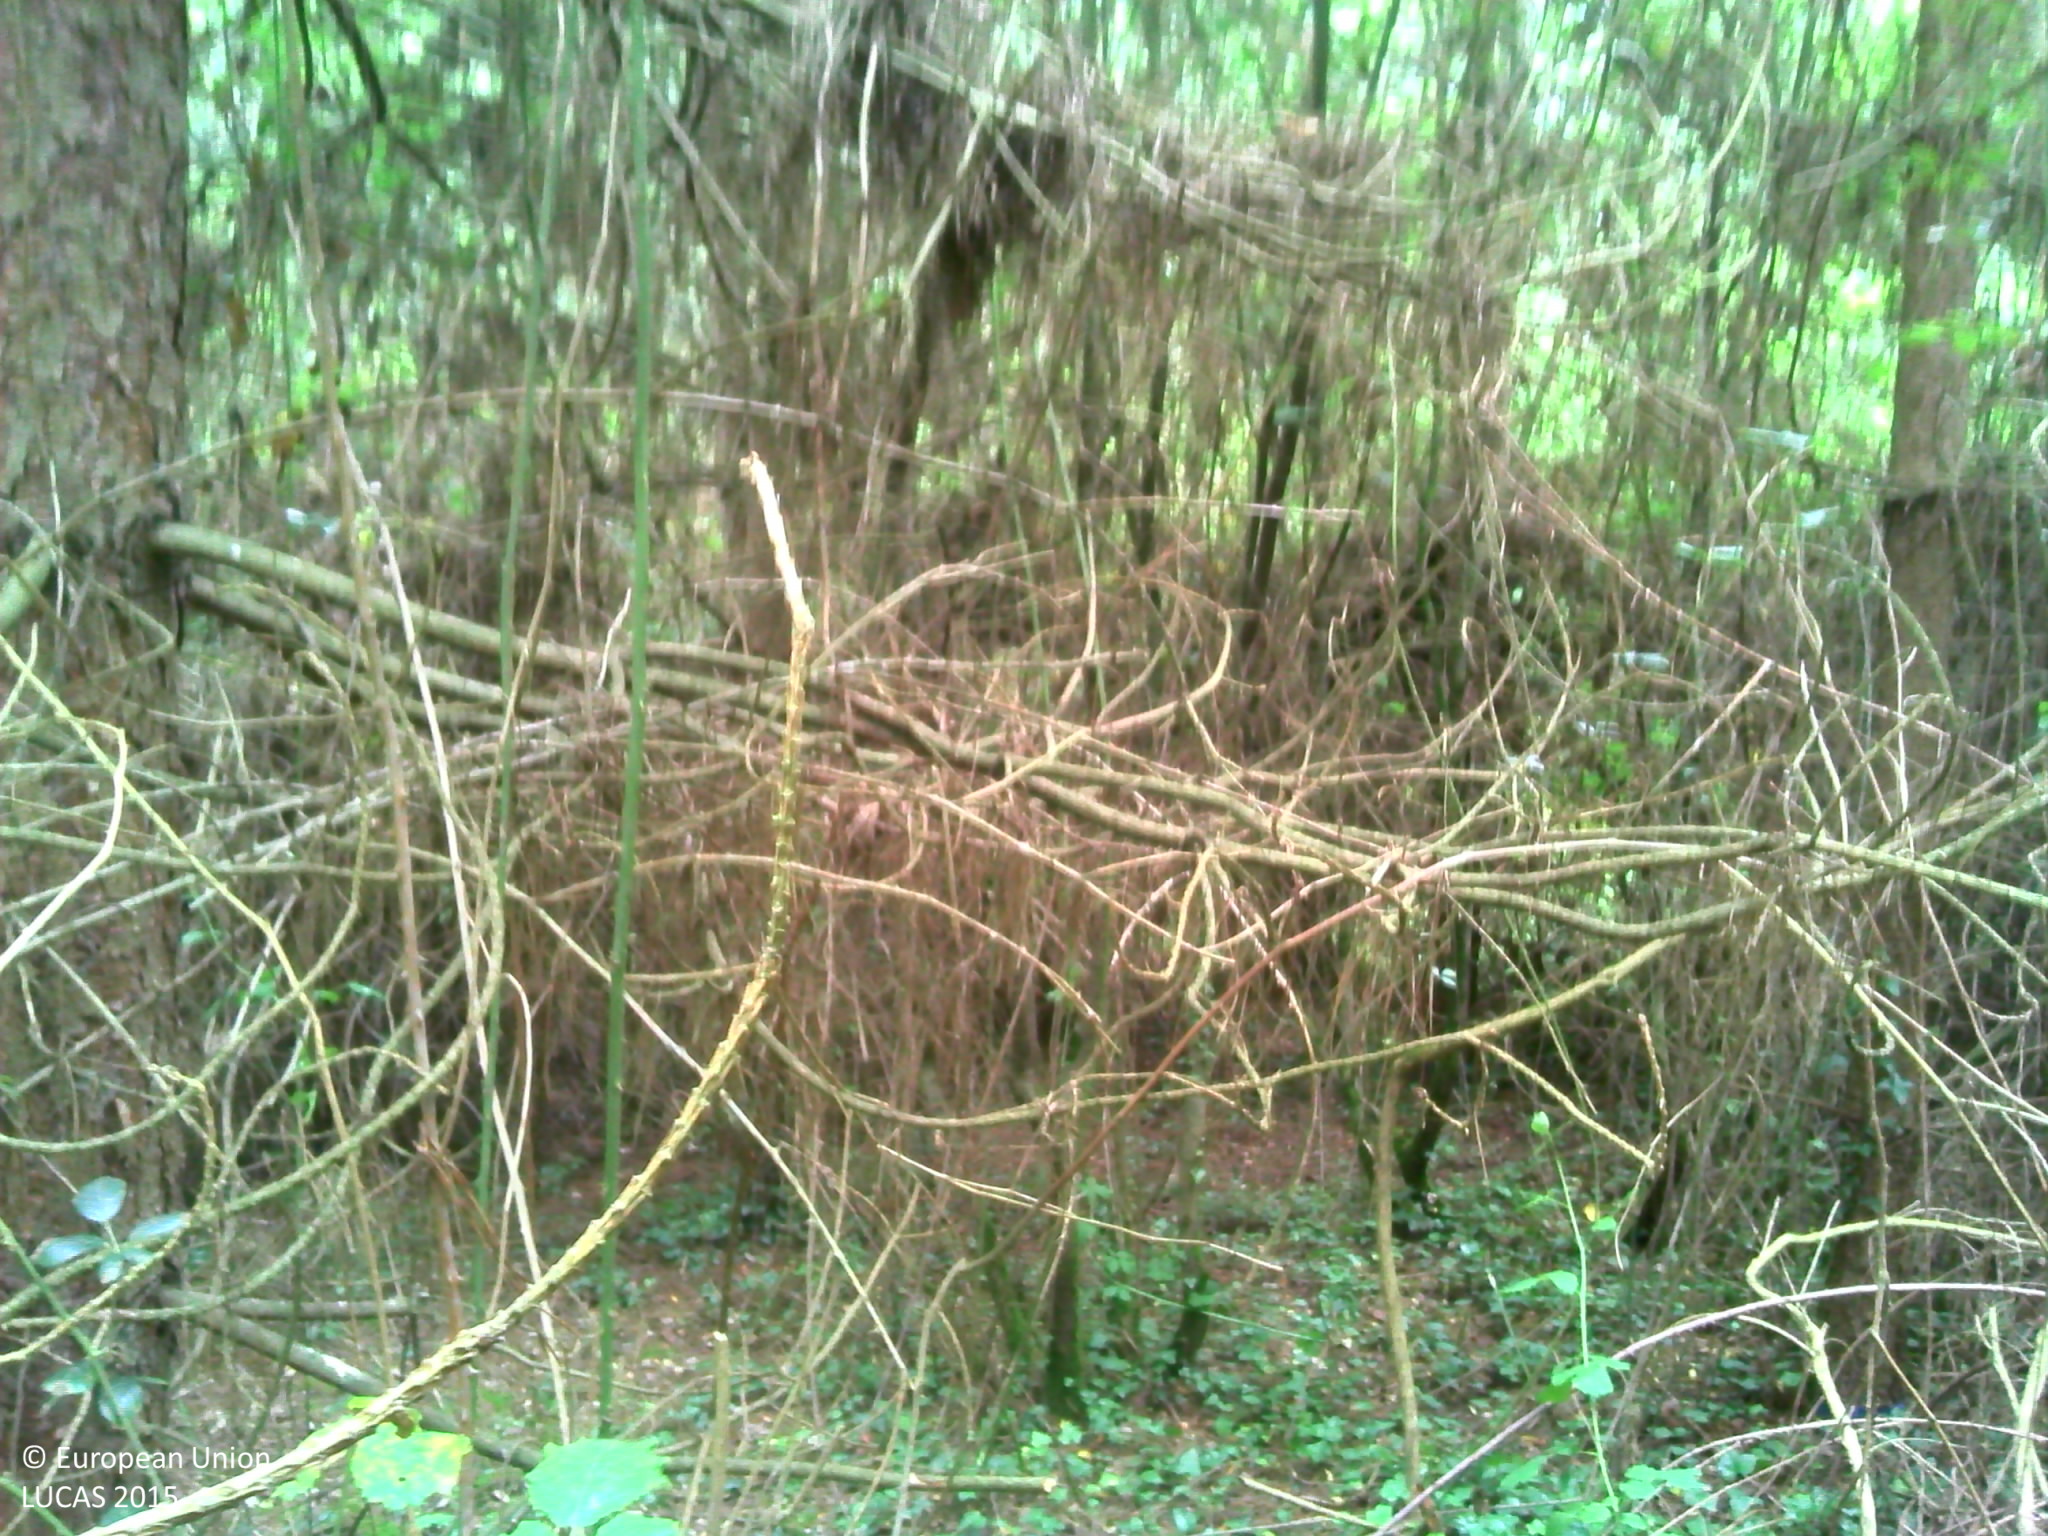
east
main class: Woodland
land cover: Pine dominated mixed woodland
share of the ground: > 75 %
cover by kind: coniferous forest trees 75 %, broadleaved forest trees 25 %
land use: Forestry
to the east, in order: Pine dominated mixed woodland; Broadleaved woodland; Ditches and canals; Broadleaved woodland; Ditches and canals; Fences; Grassland without tree/shrub cover; Fences; Managed hedges
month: July
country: FR
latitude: 46.6934
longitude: -1.8251
